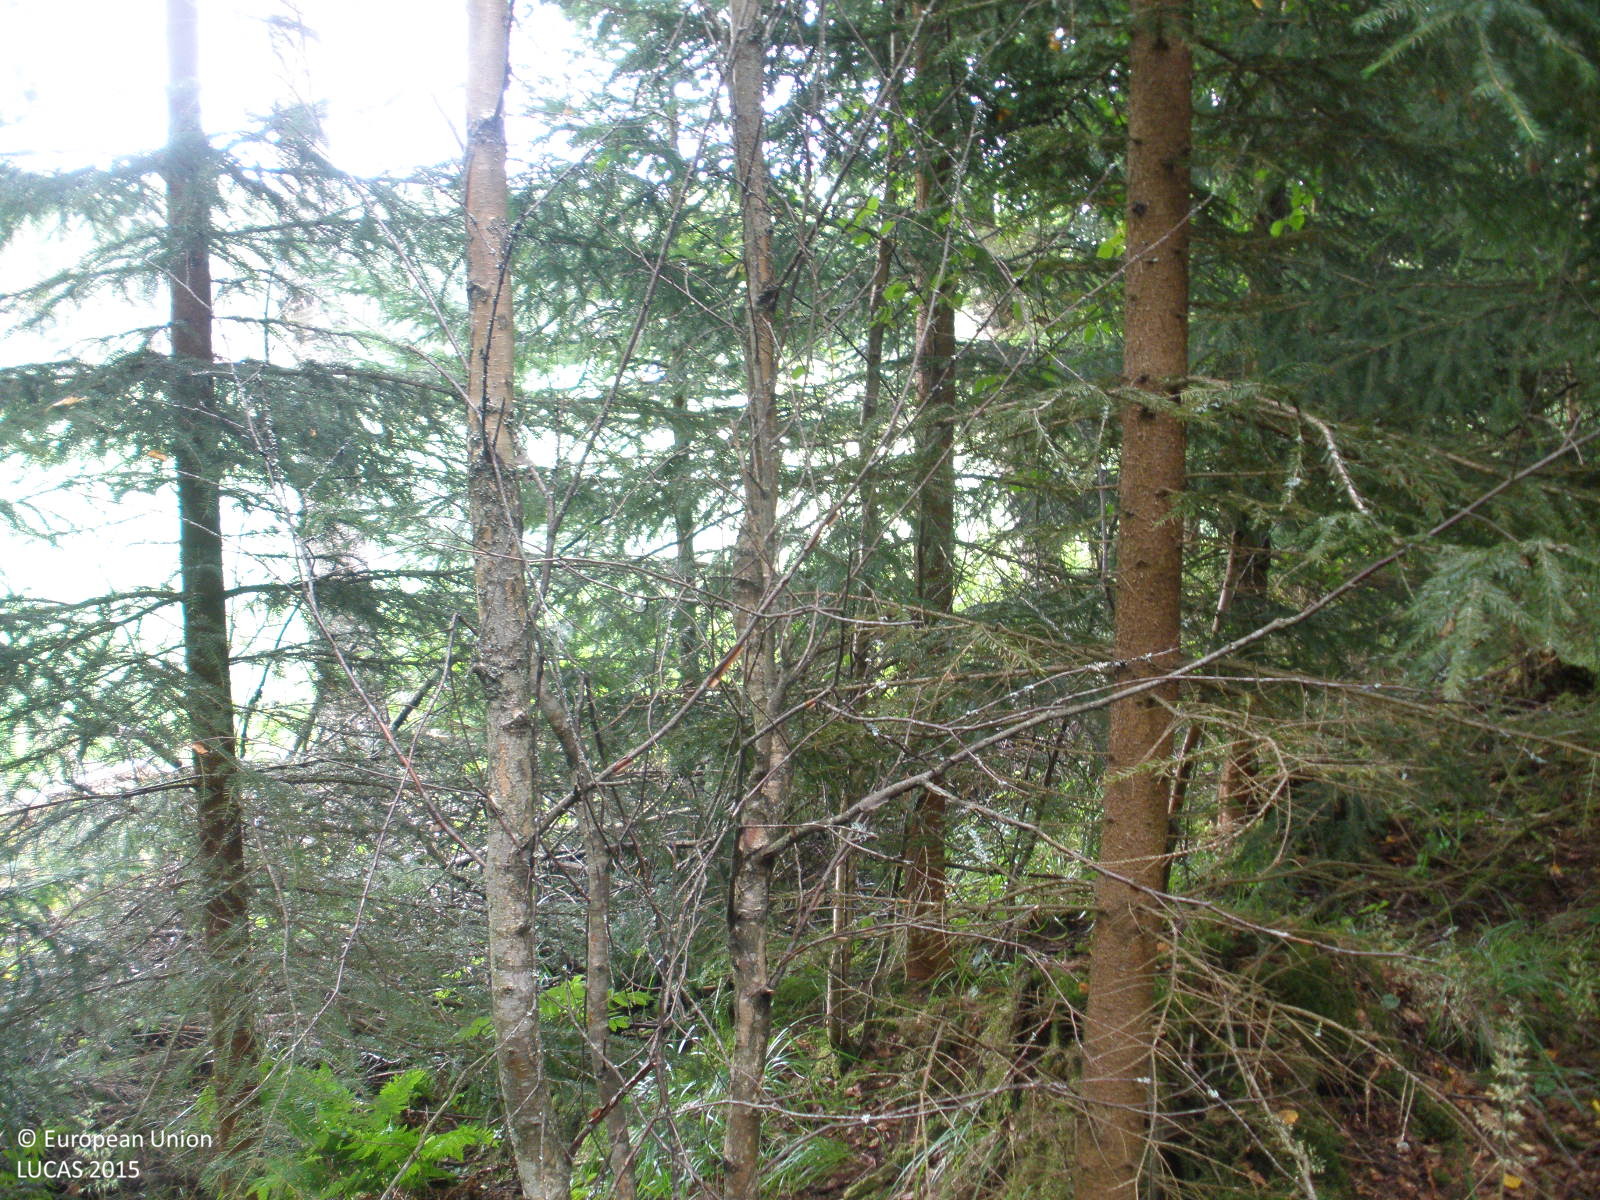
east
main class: Woodland
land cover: Spruce dominated mixed woodland
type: boreal forest
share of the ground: > 75 %
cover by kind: broadleaved forest trees 45 %, coniferous forest trees 30 %, herbaceous plants 15 %, lichens and mosses 10 %
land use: Forestry
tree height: > 5 m
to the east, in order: Spruce dominated mixed woodland; Ditches and canals; Grass margins; Oats; Ditches and canals; Grass margins; Tracks; Grass margins; Ditches and canals; Spruce dominated mixed woodland; Oats; Spruce dominated coniferous woodland; Spruce dominated mixed woodland; Tracks; Spruce dominated mixed woodland; Tracks; Spruce dominated mixed woodland
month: August
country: FI
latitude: 60.8031
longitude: 24.4933
